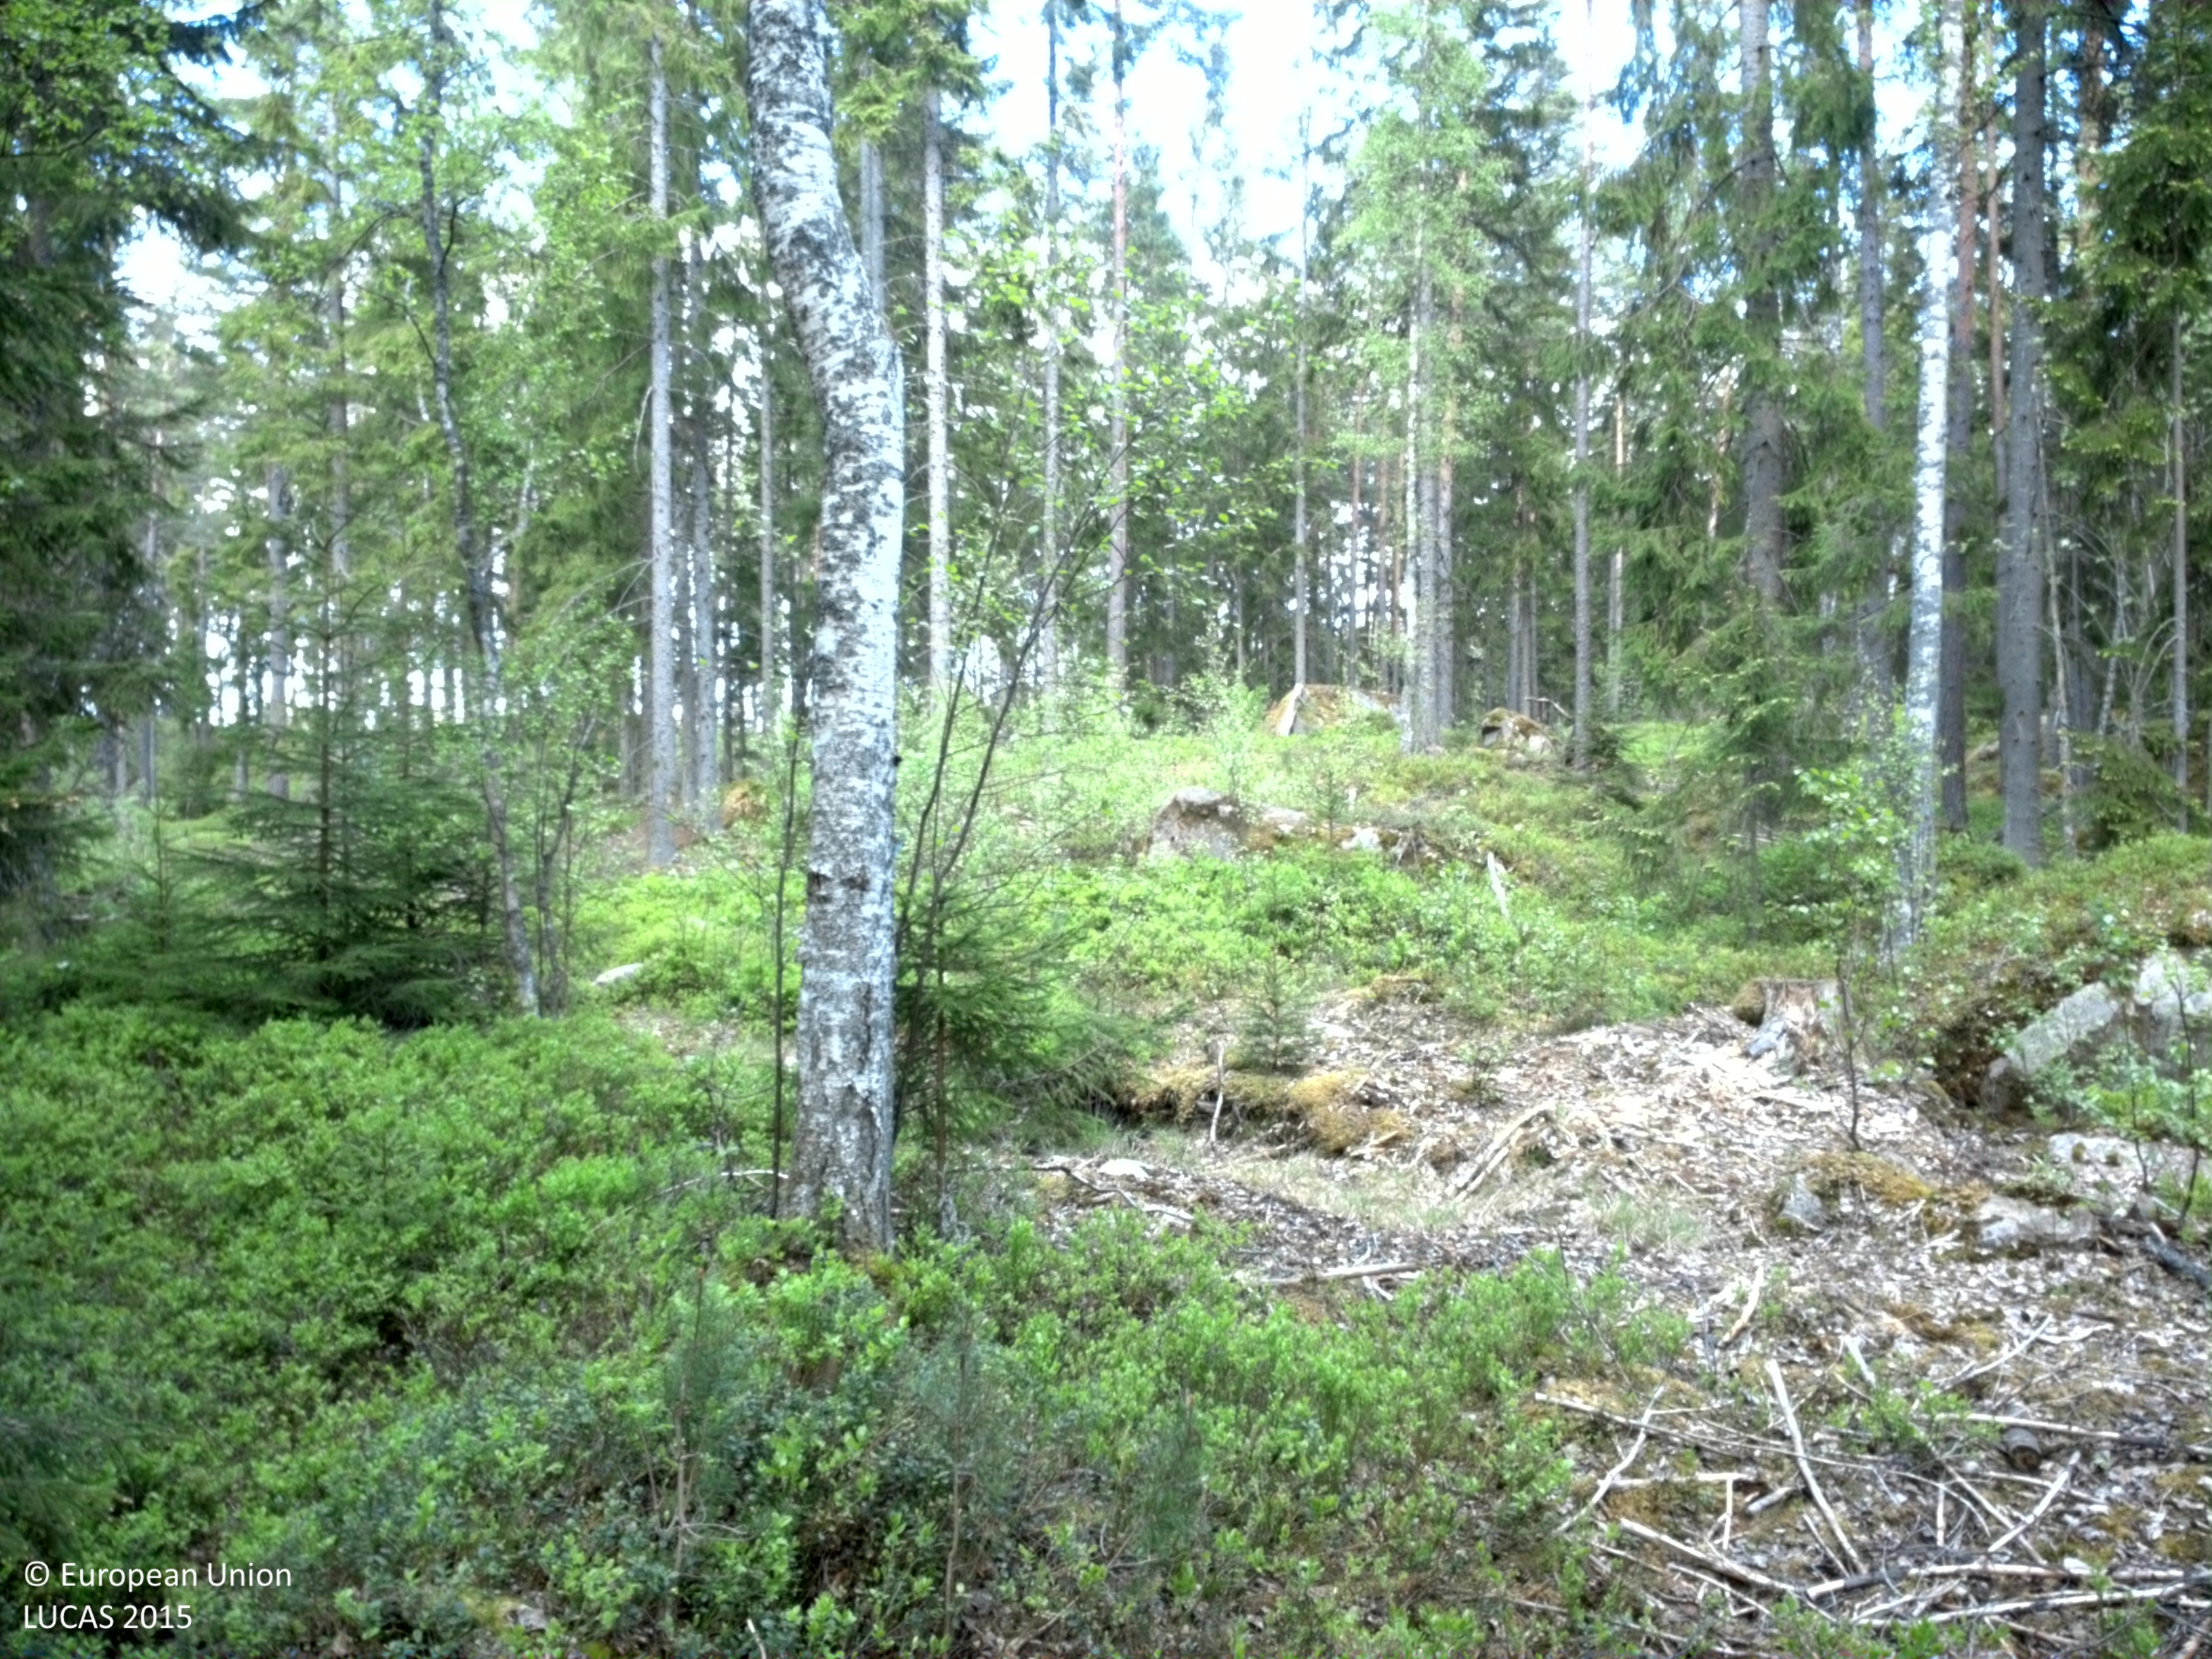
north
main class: Woodland
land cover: Spruce dominated mixed woodland
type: boreal forest
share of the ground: 50 - 75 %
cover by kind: broadleaved forest trees 50 %, coniferous forest trees 20 %, lichens and mosses 20 %, herbaceous plants 10 %
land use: Forestry
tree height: > 5 m
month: May
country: SE
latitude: 56.7512
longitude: 15.1493
